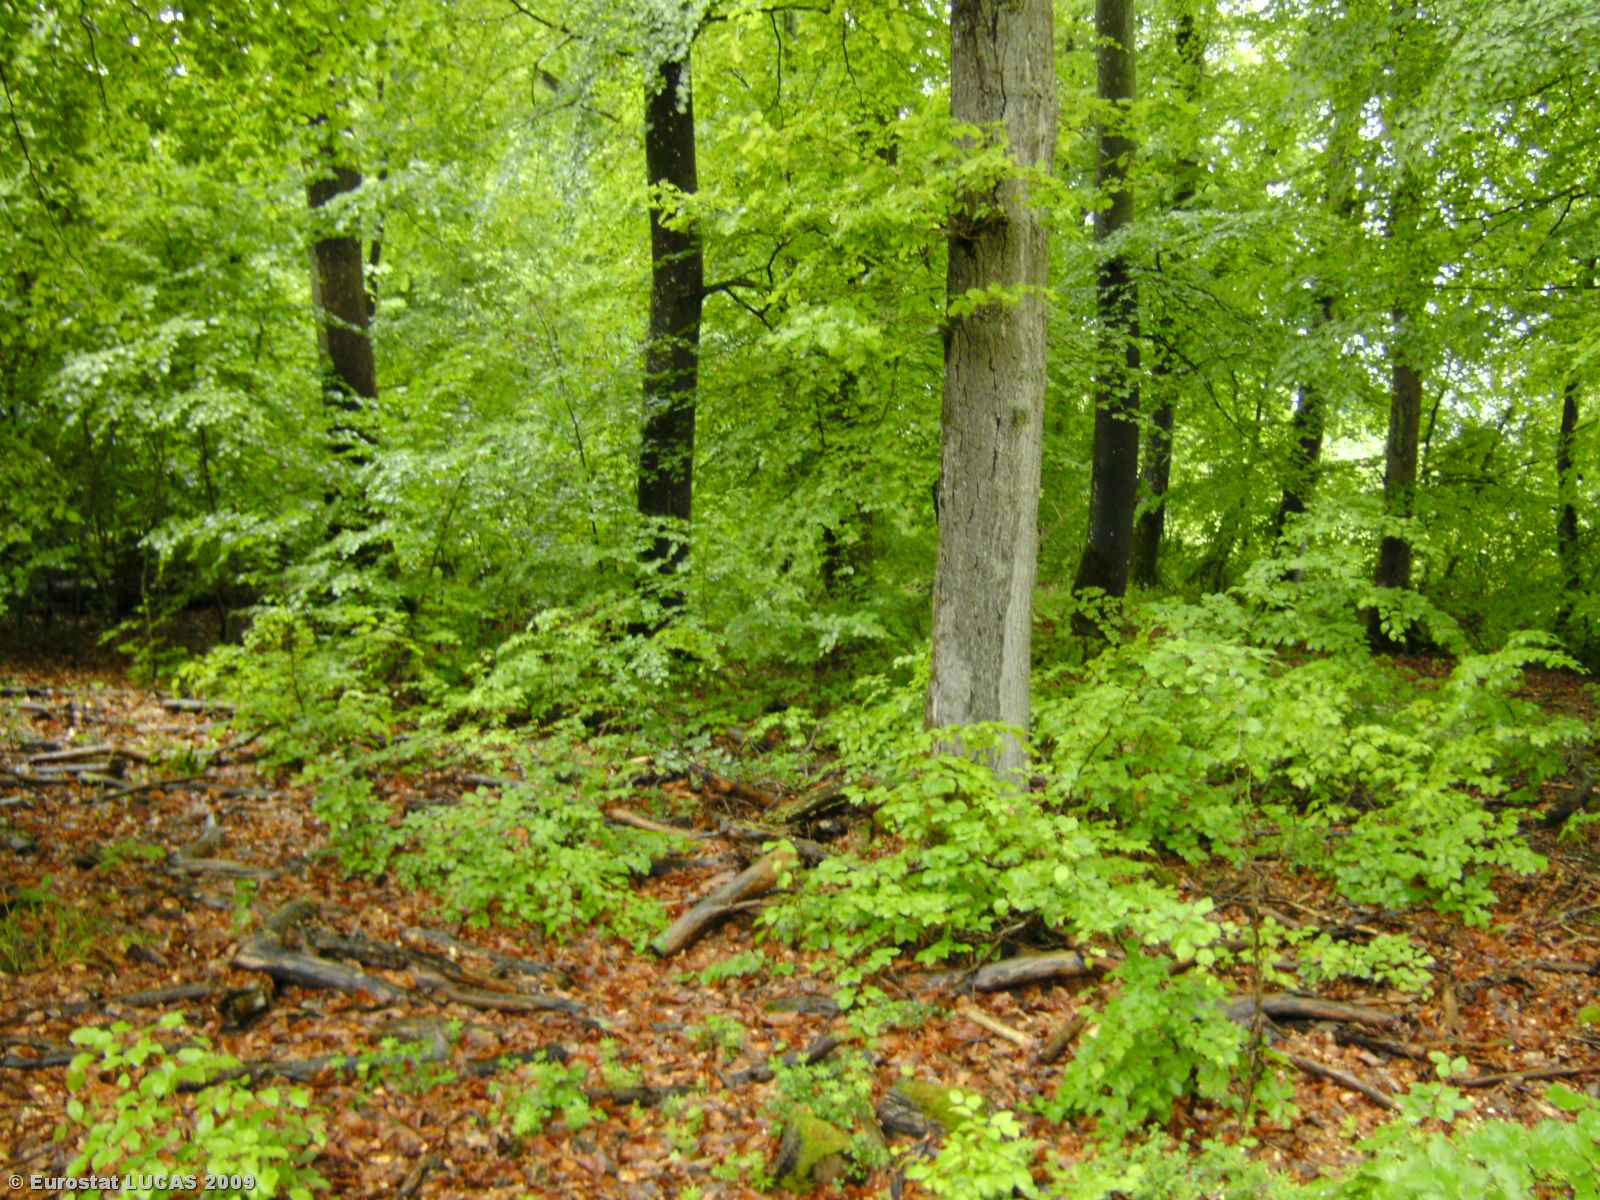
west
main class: Woodland
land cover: Broadleaved woodland
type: beech forest
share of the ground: 50 - 75 %
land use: Forestry
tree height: > 5 m
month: May
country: LU
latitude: 49.8178
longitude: 6.2886
